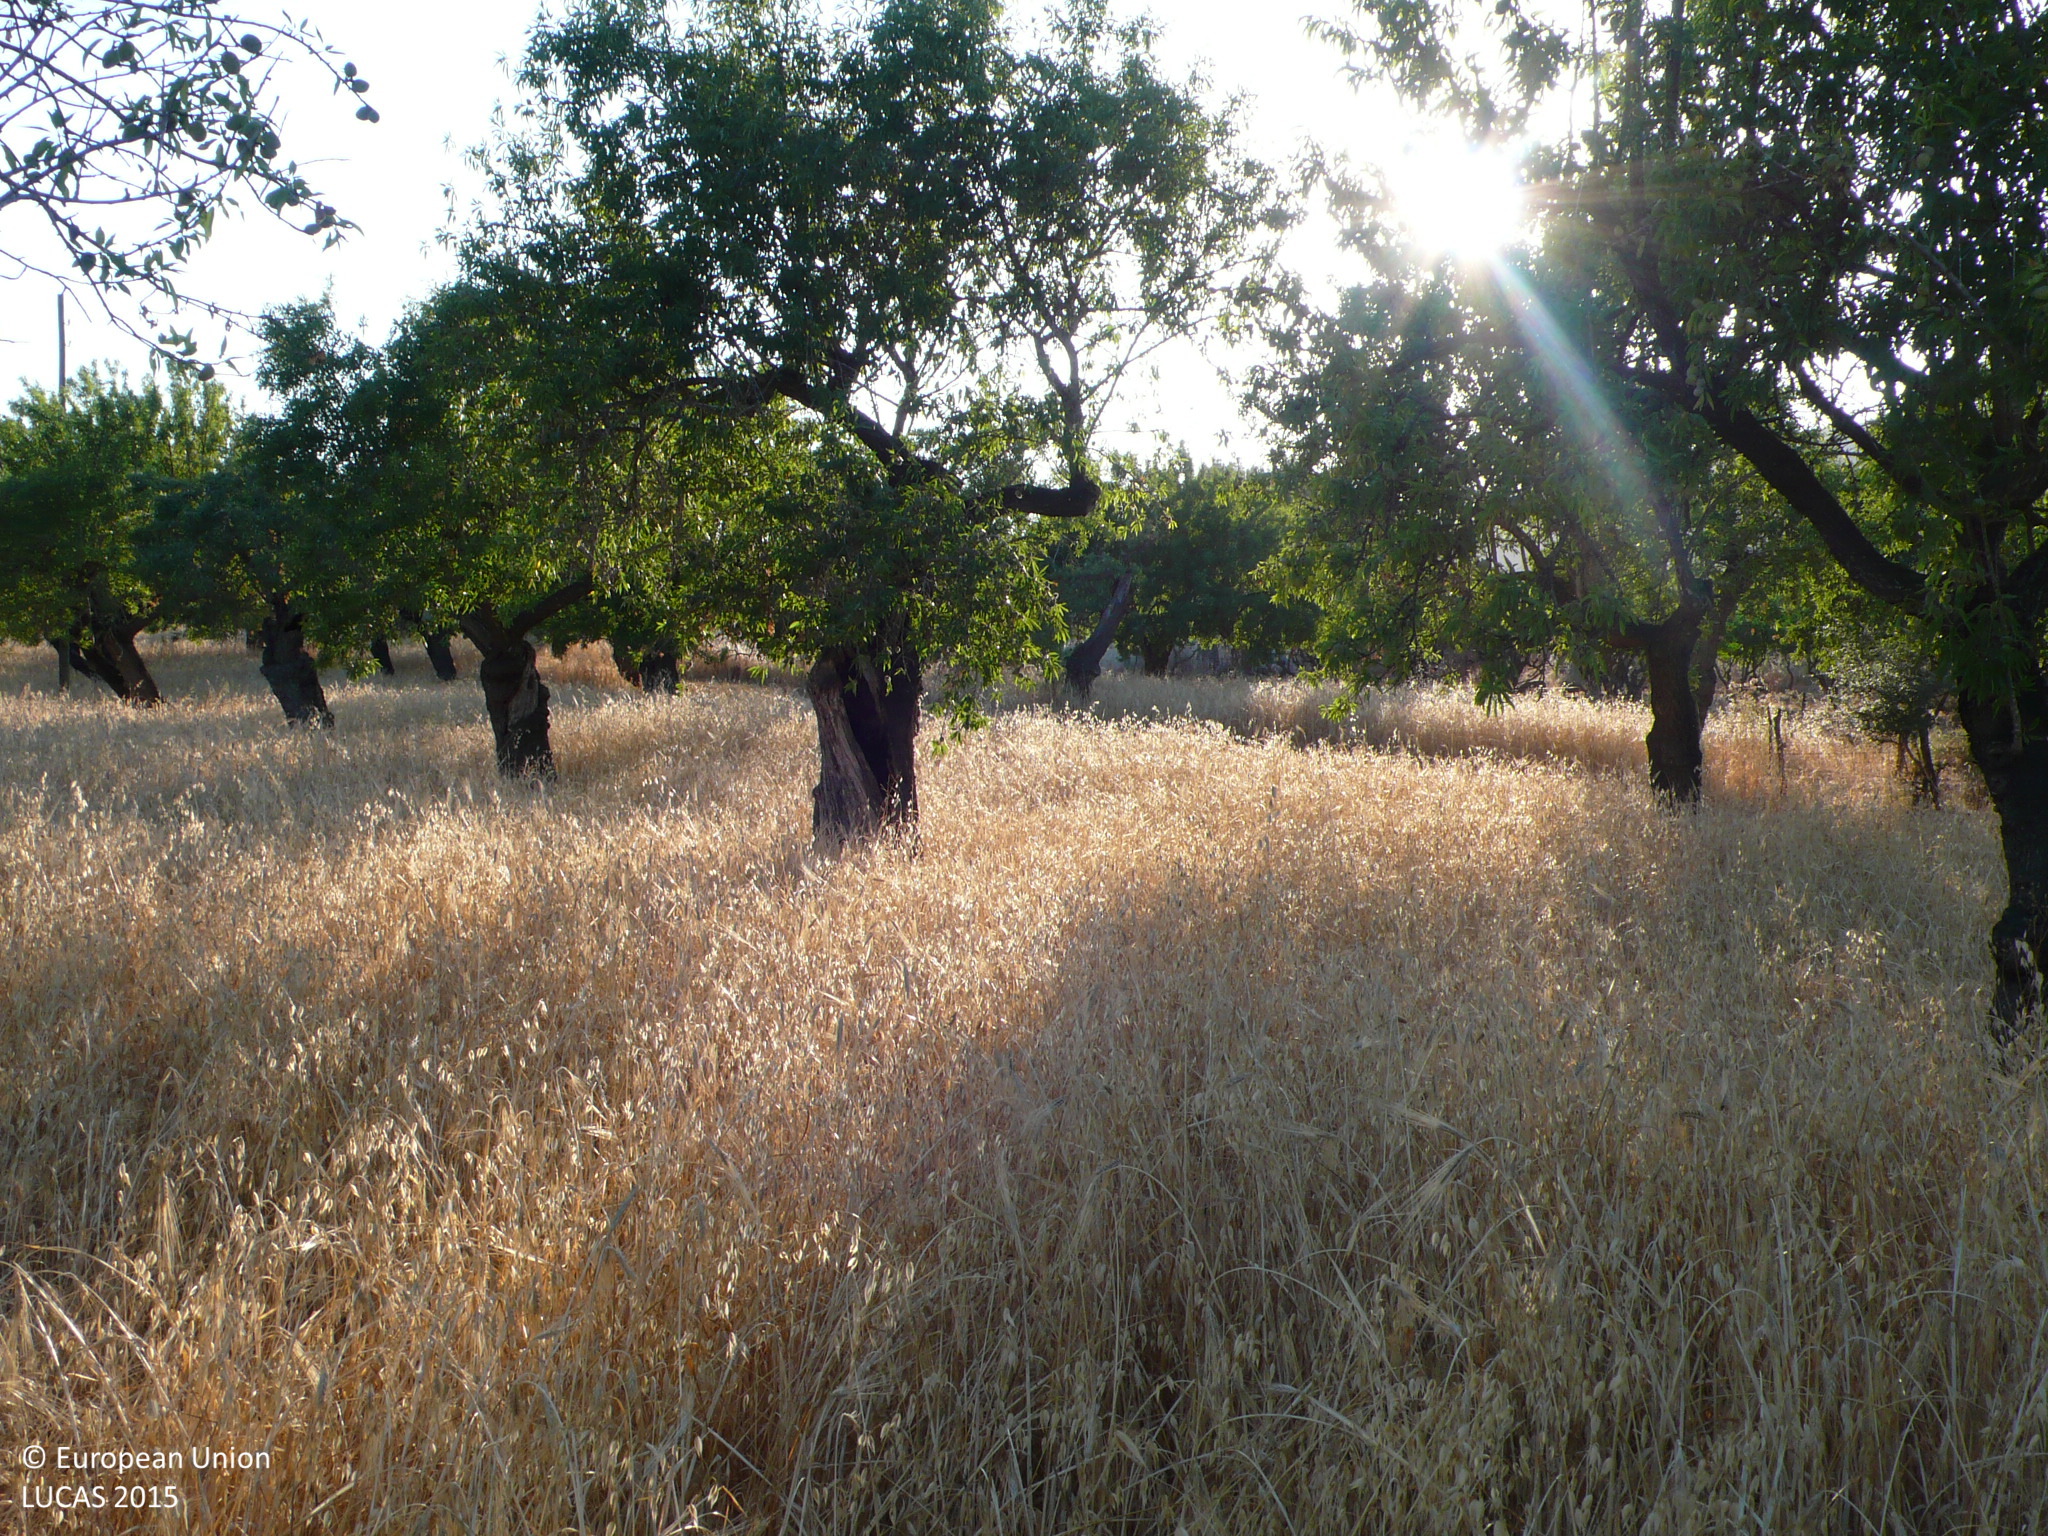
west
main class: Cropland
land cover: Nuts trees
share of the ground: 25 - 50 %
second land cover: Barley
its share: > 75 %
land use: Agriculture (excluding fallow land and kitchen gardens)
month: June
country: ES
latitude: 39.7176
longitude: 2.8785
